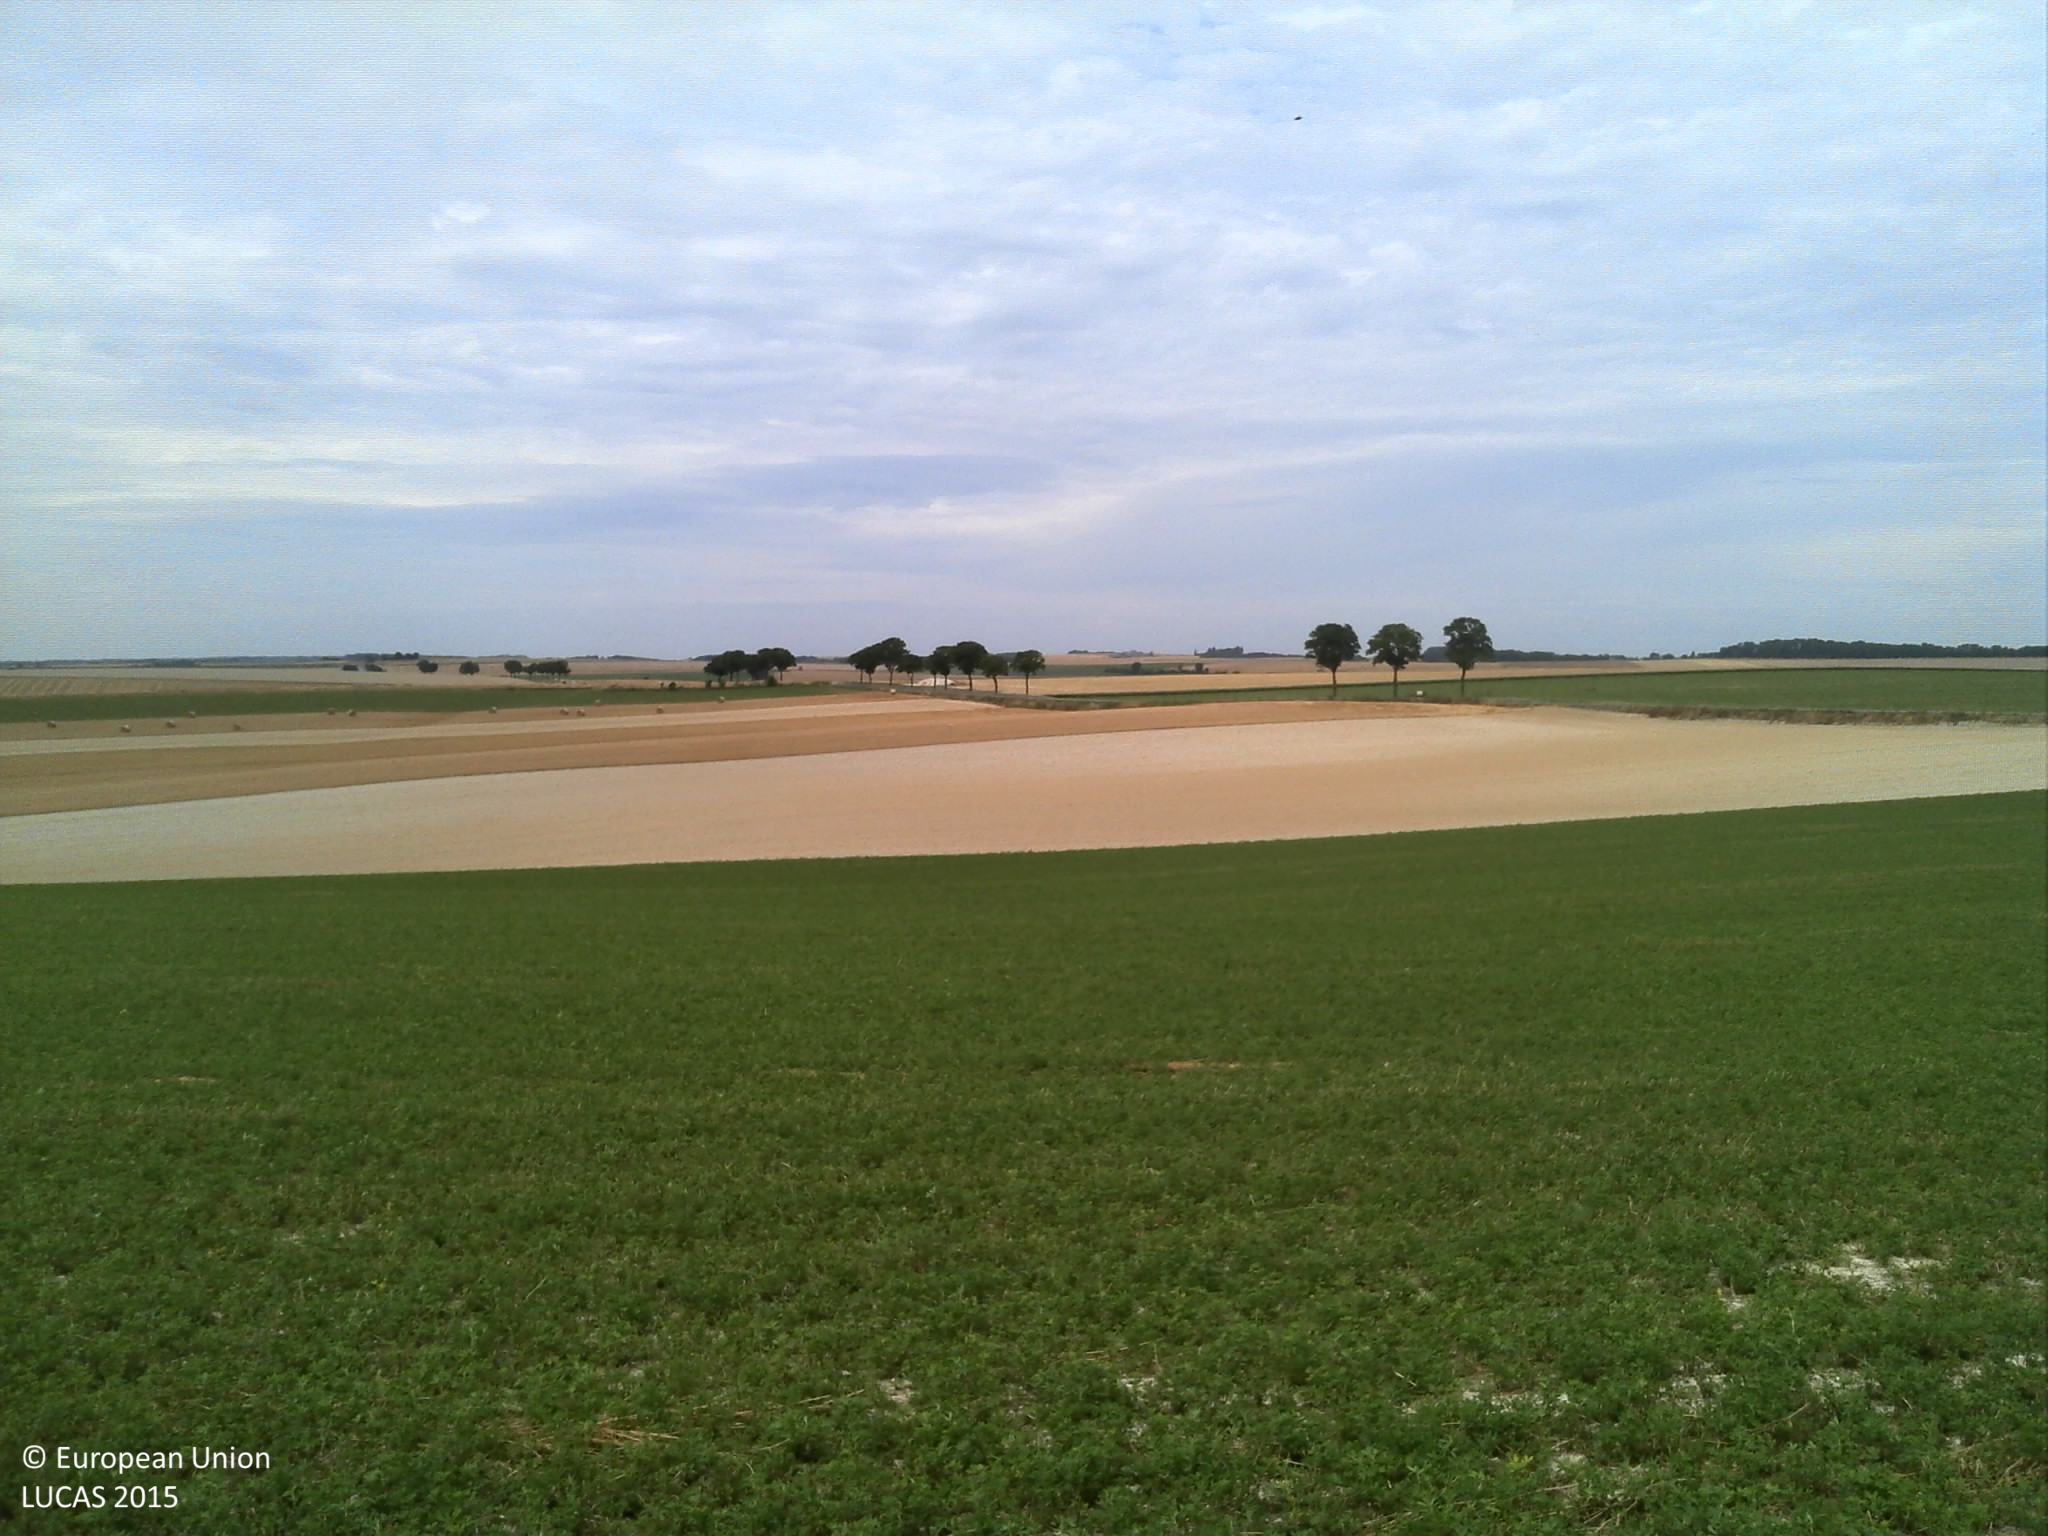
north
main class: Cropland
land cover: Lucerne
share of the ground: > 75 %
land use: Agriculture (excluding fallow land and kitchen gardens)
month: July
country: FR
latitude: 49.5707
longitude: 4.2569
